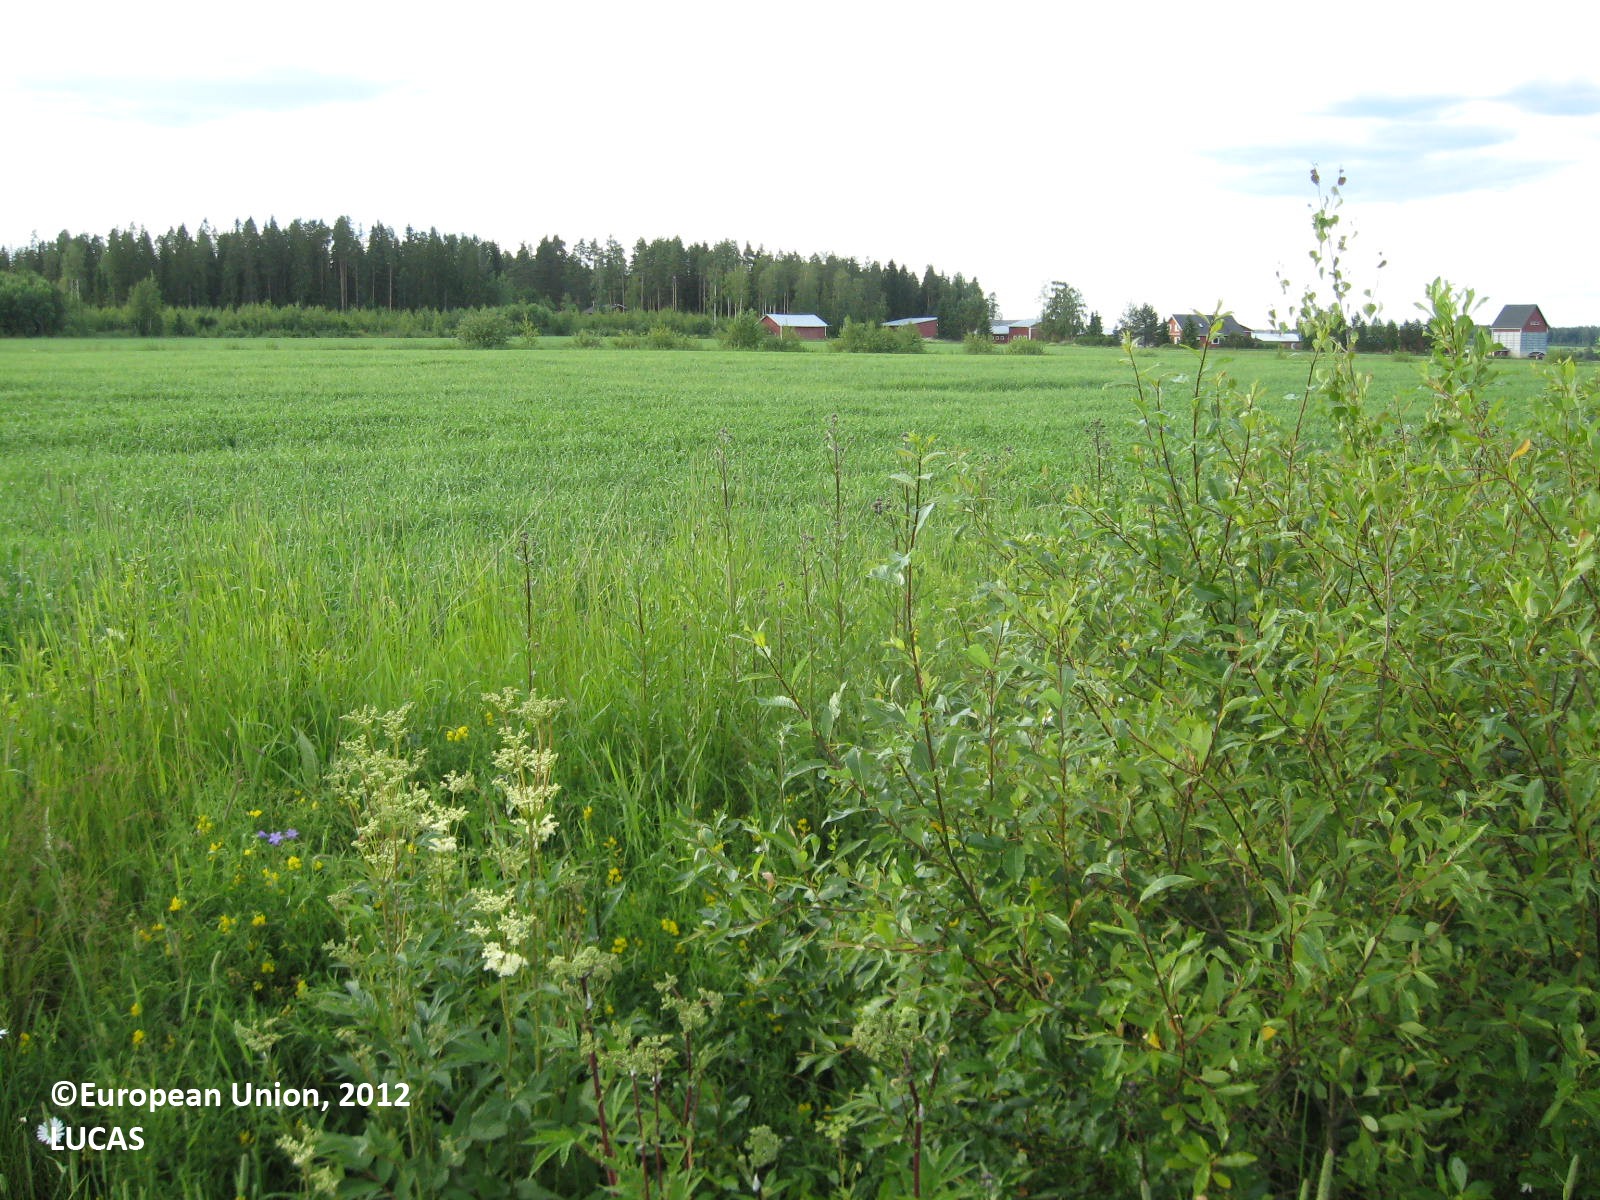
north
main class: Cropland
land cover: Barley
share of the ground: > 75 %
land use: Agriculture (excluding fallow land and kitchen gardens)
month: July
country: FI
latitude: 62.5354
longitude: 22.6321
